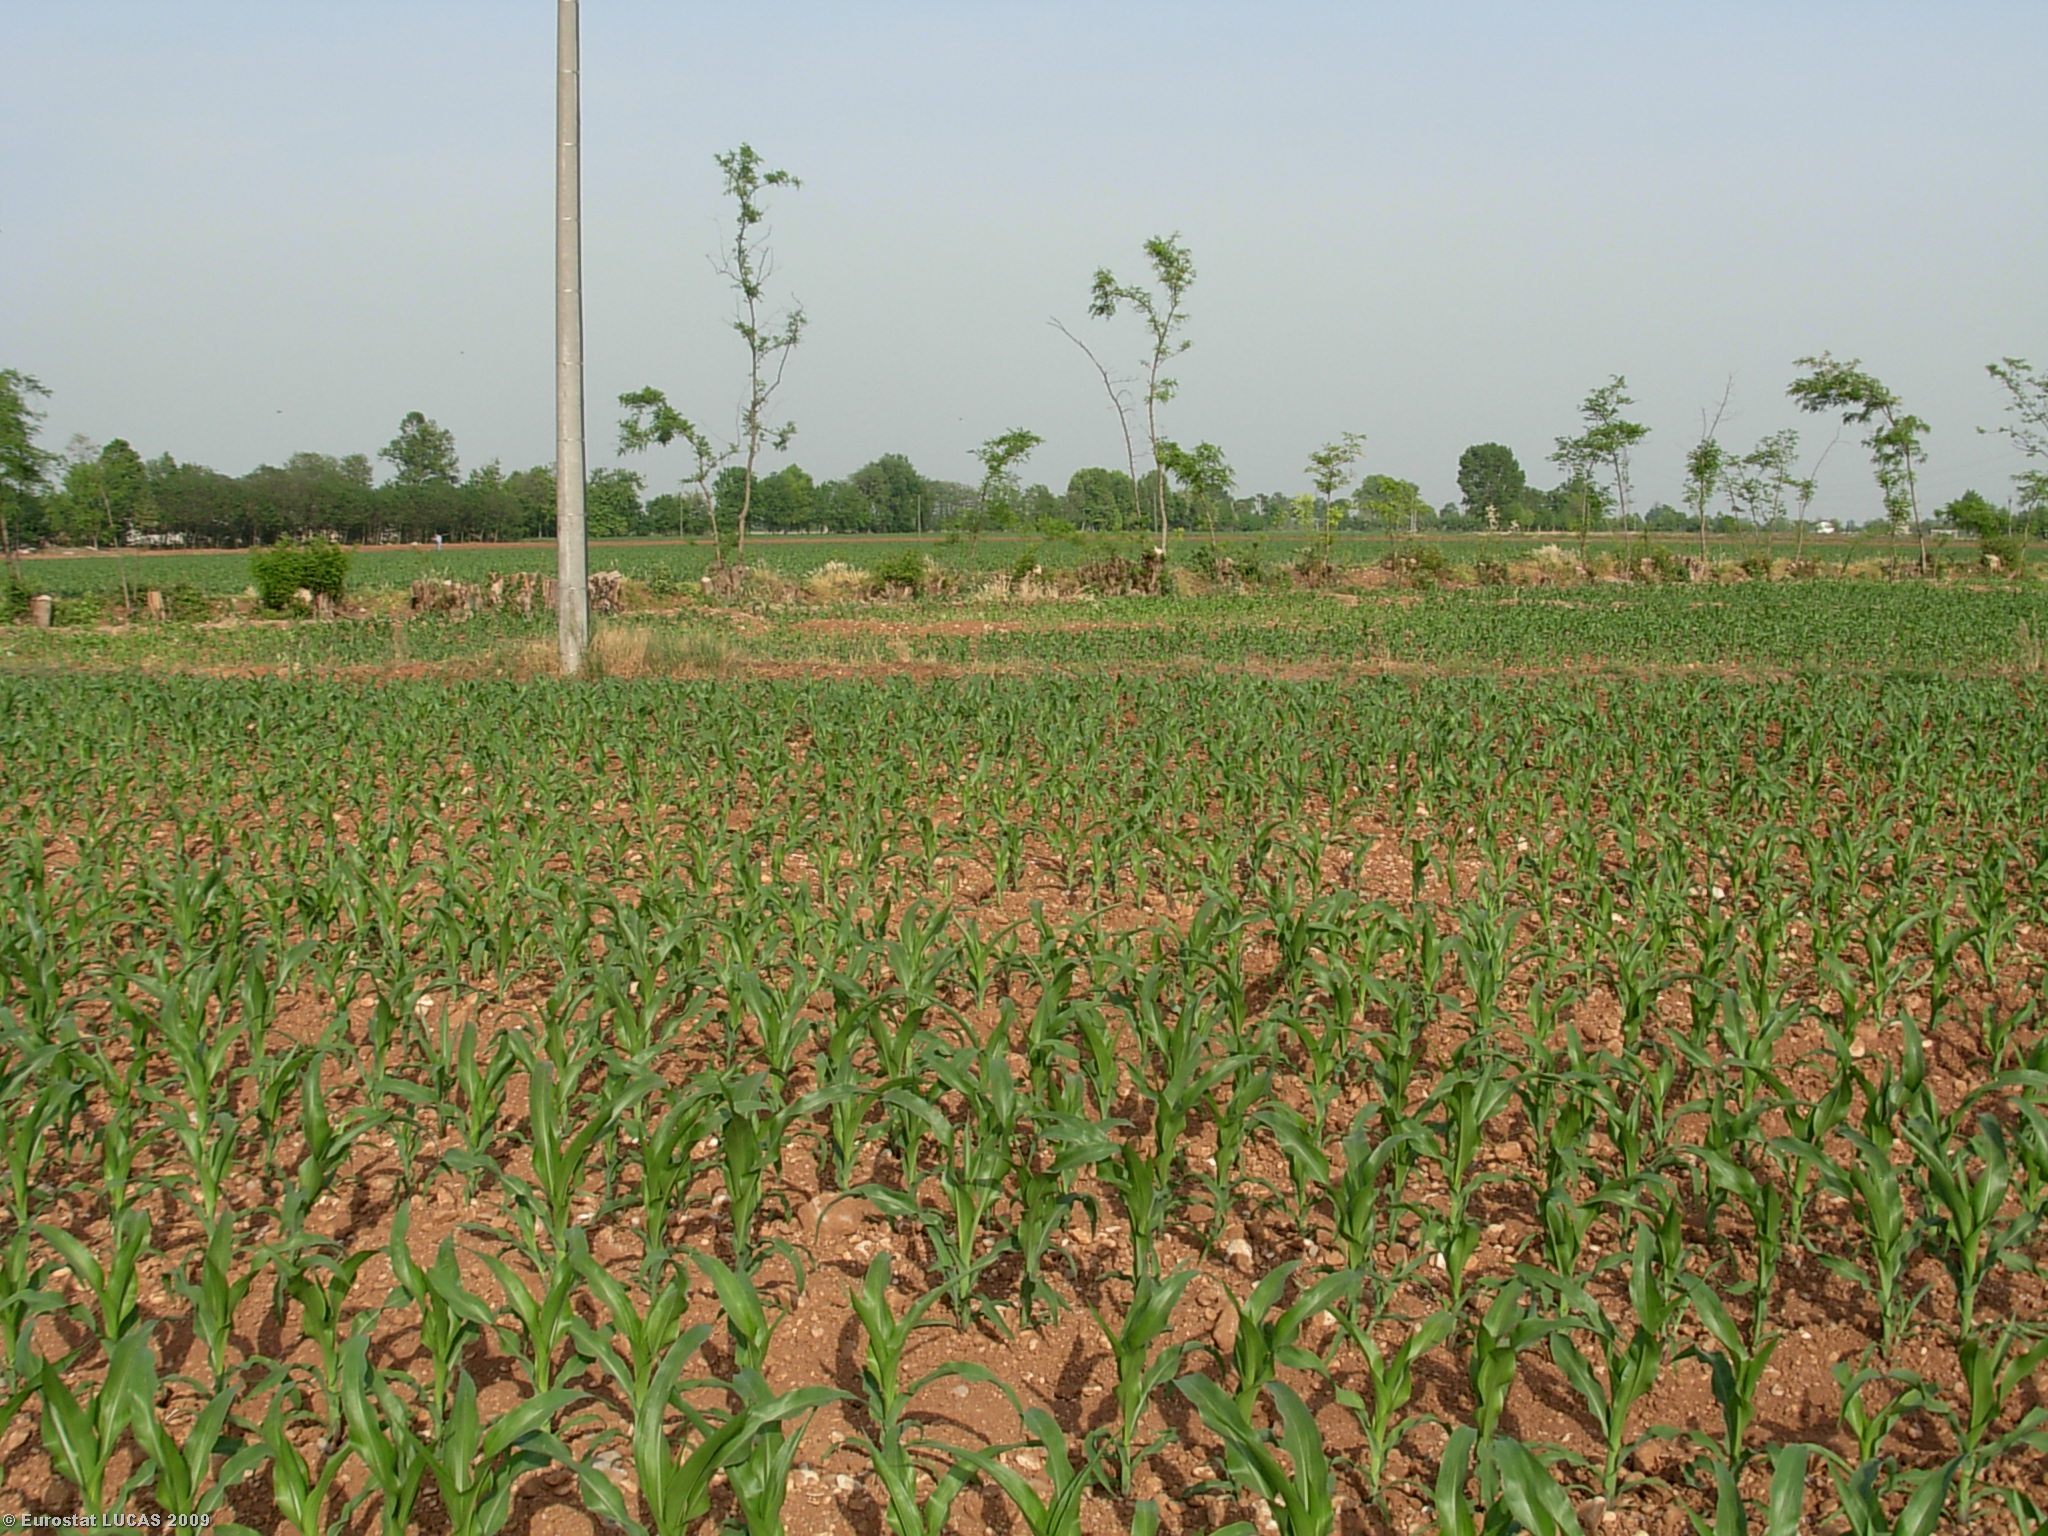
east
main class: Cropland
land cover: Maize
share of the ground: 50 - 75 %
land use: Agriculture (excluding fallow land and kitchen gardens)
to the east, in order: Maize; Grass margins; Electric lines; Maize; Grass margins; Managed hedges; Paved roads, cycling and walking lanes; Maize
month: May
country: IT
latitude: 45.3958
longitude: 10.3188
